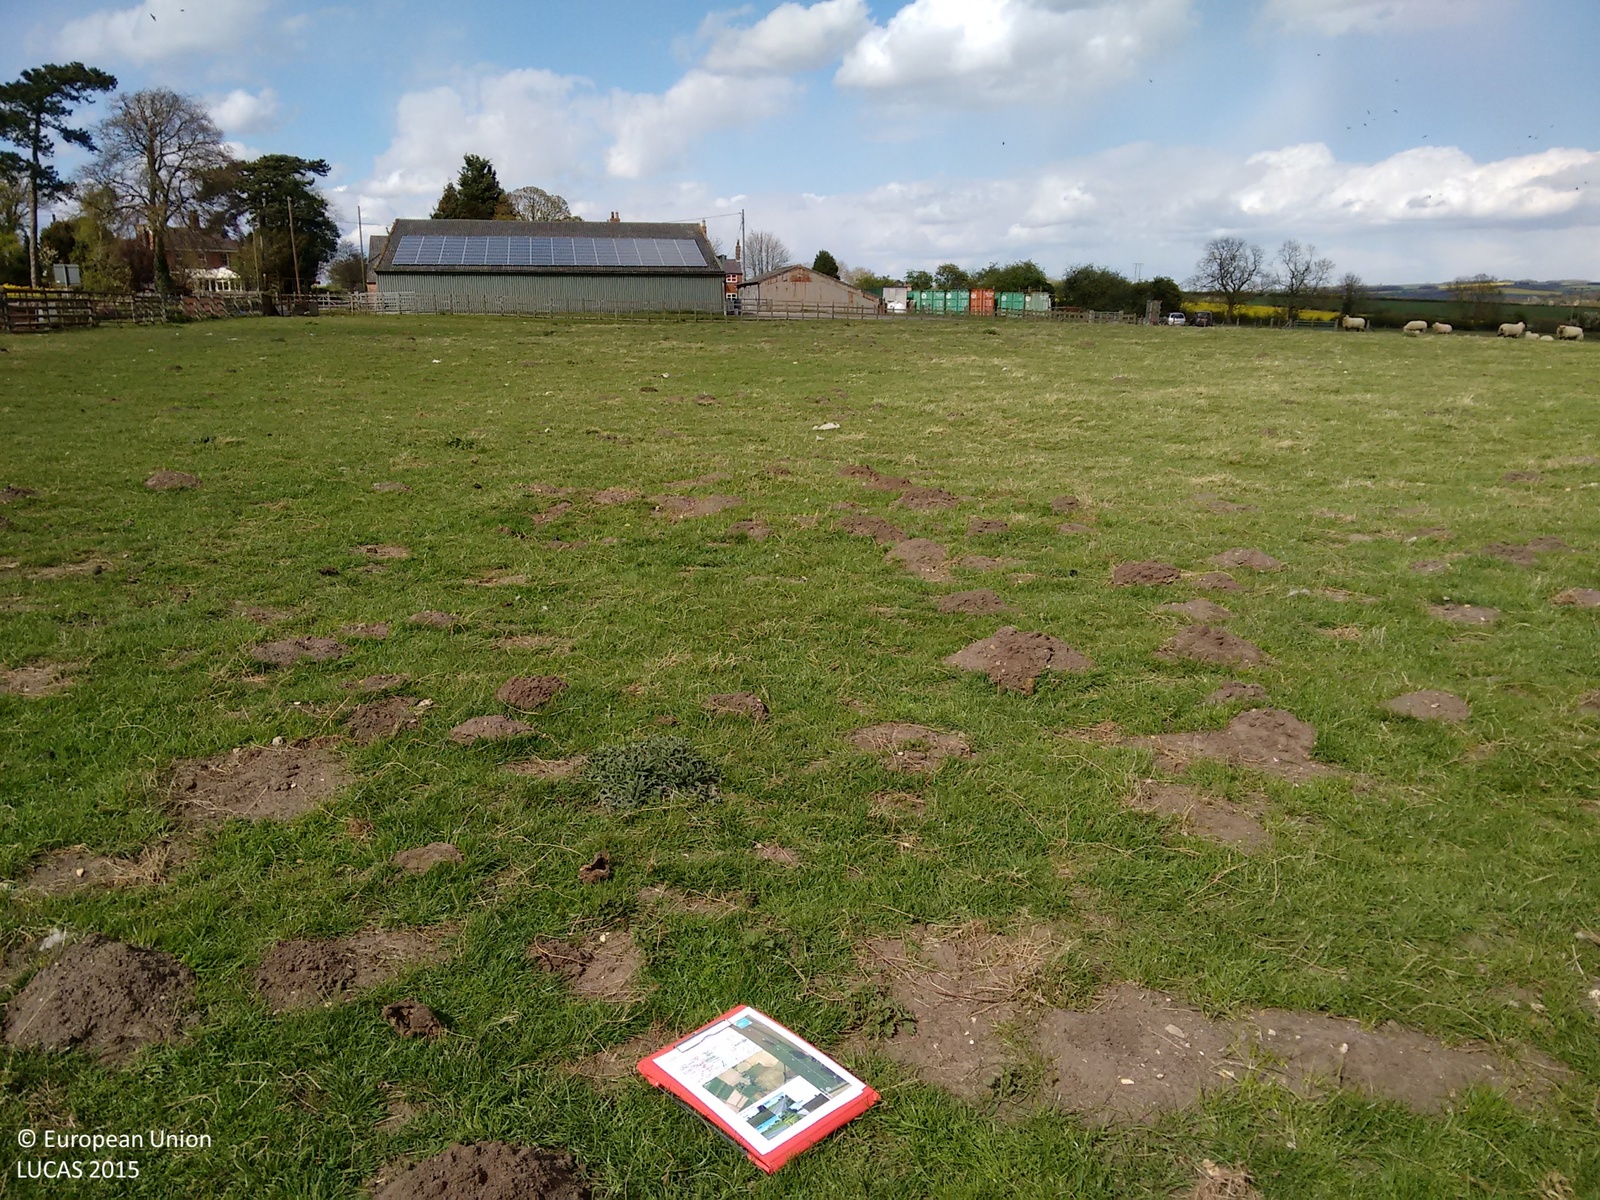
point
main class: Grassland
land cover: Grassland without tree/shrub cover
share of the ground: > 75 %
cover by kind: herbaceous plants 100 %
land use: Agriculture (excluding fallow land and kitchen gardens)
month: April
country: GB
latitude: 53.1930
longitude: -0.1365
